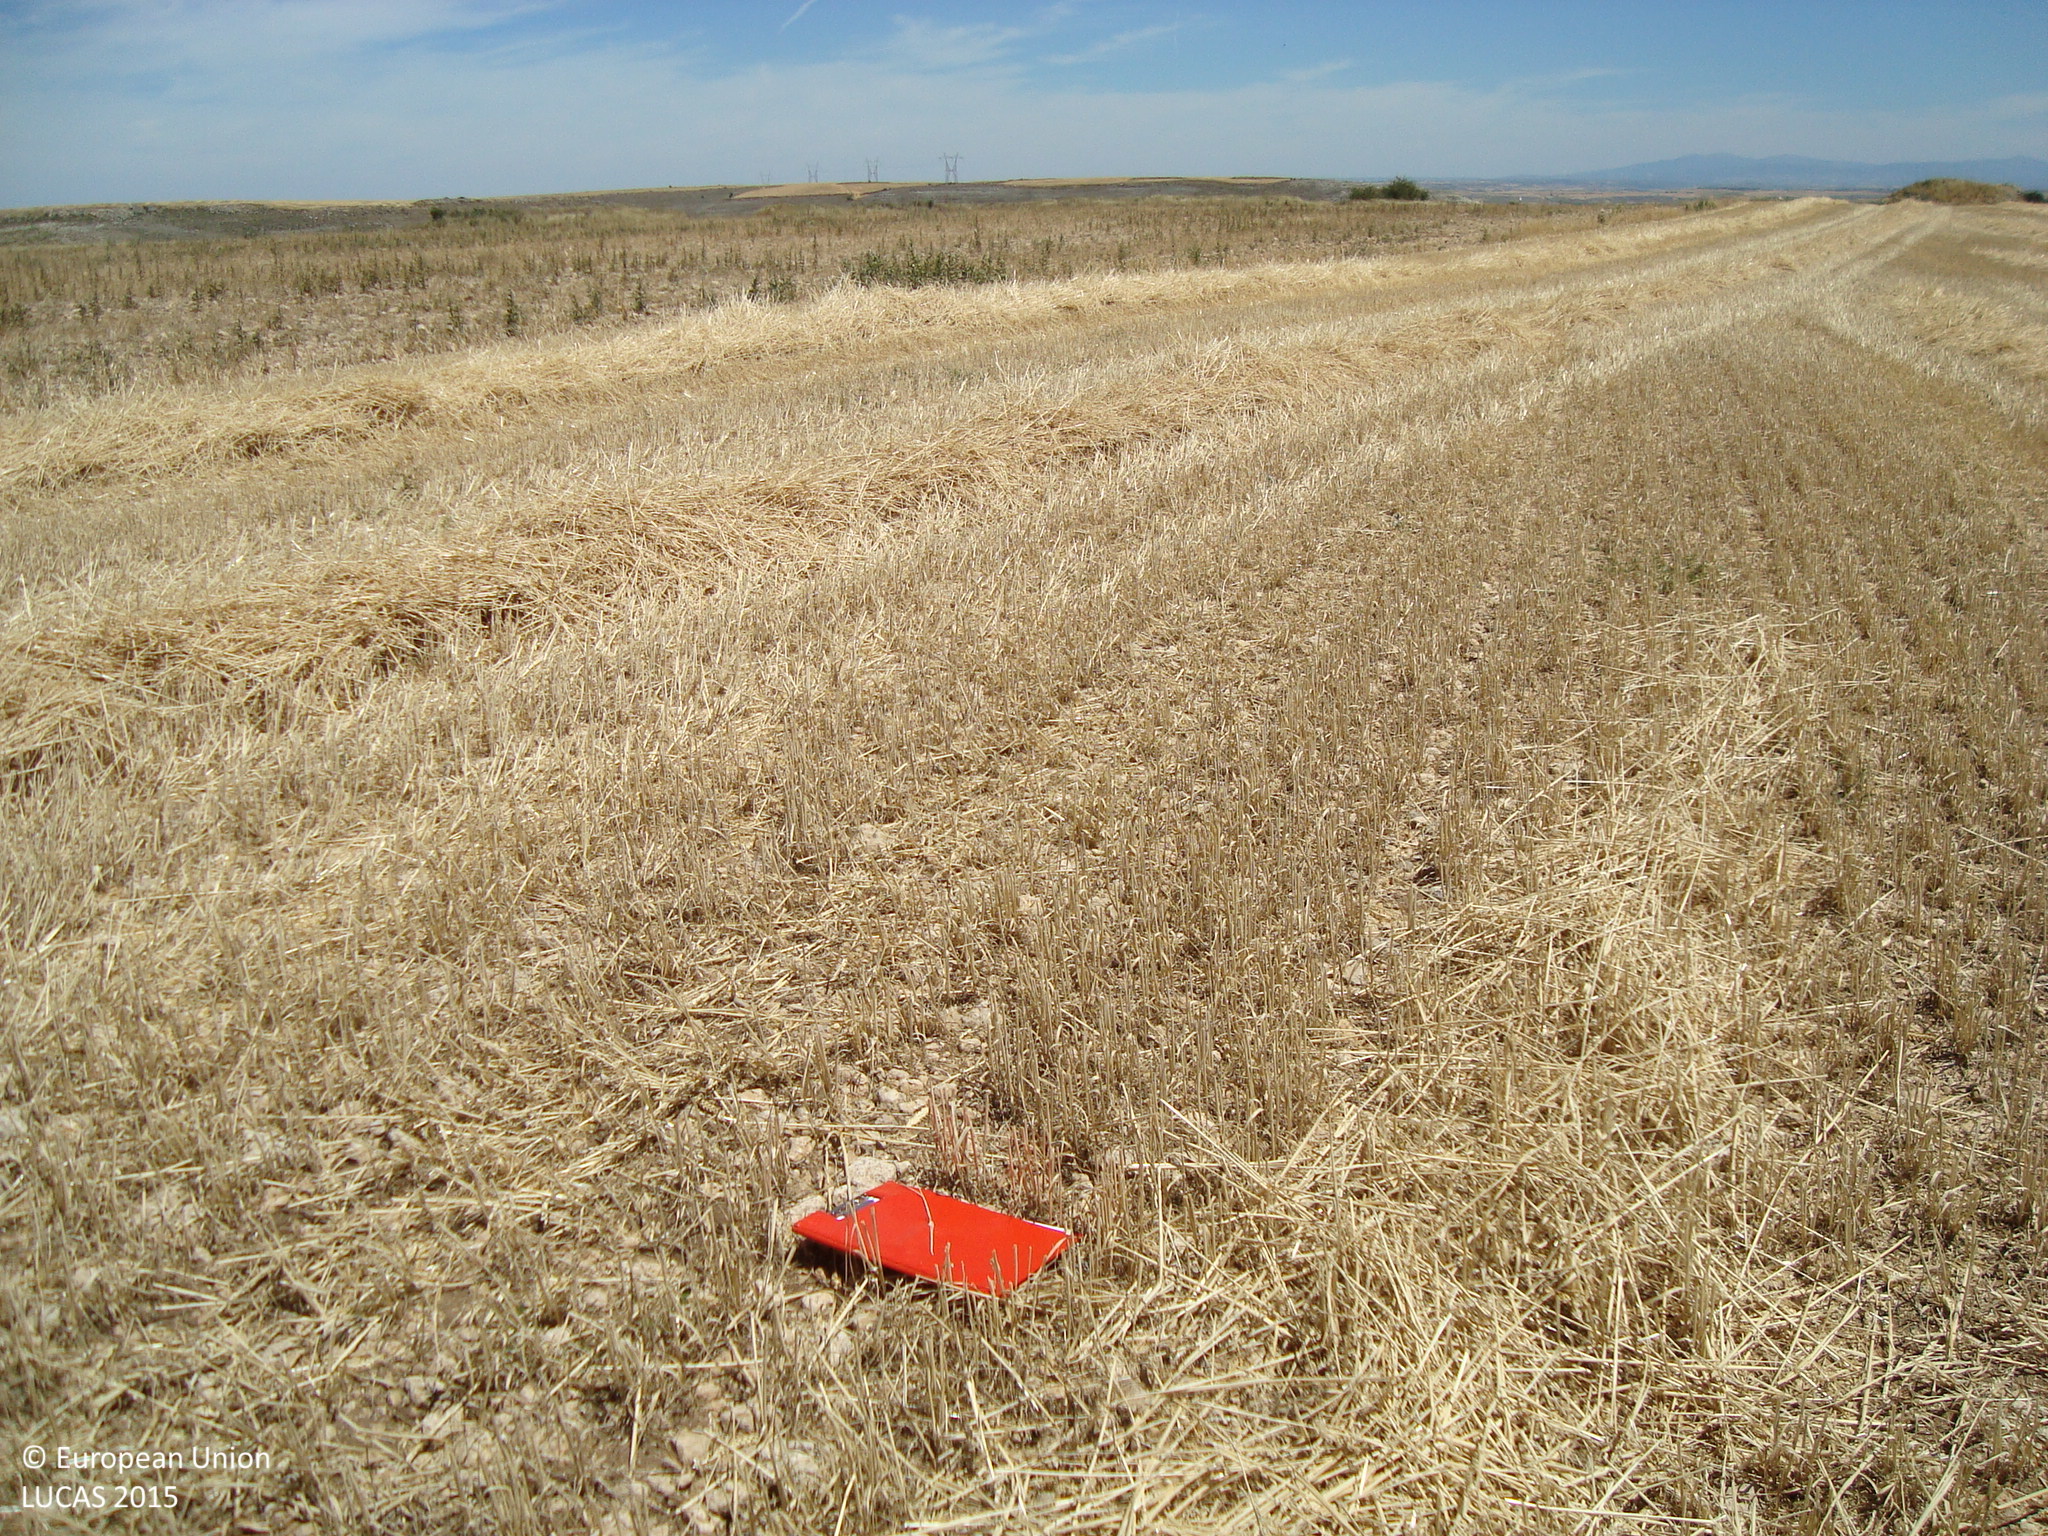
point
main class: Cropland
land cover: Common wheat
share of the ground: < 10 %
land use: Agriculture (excluding fallow land and kitchen gardens)
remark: Harvested field
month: July
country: ES
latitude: 42.2662
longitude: -3.9695
